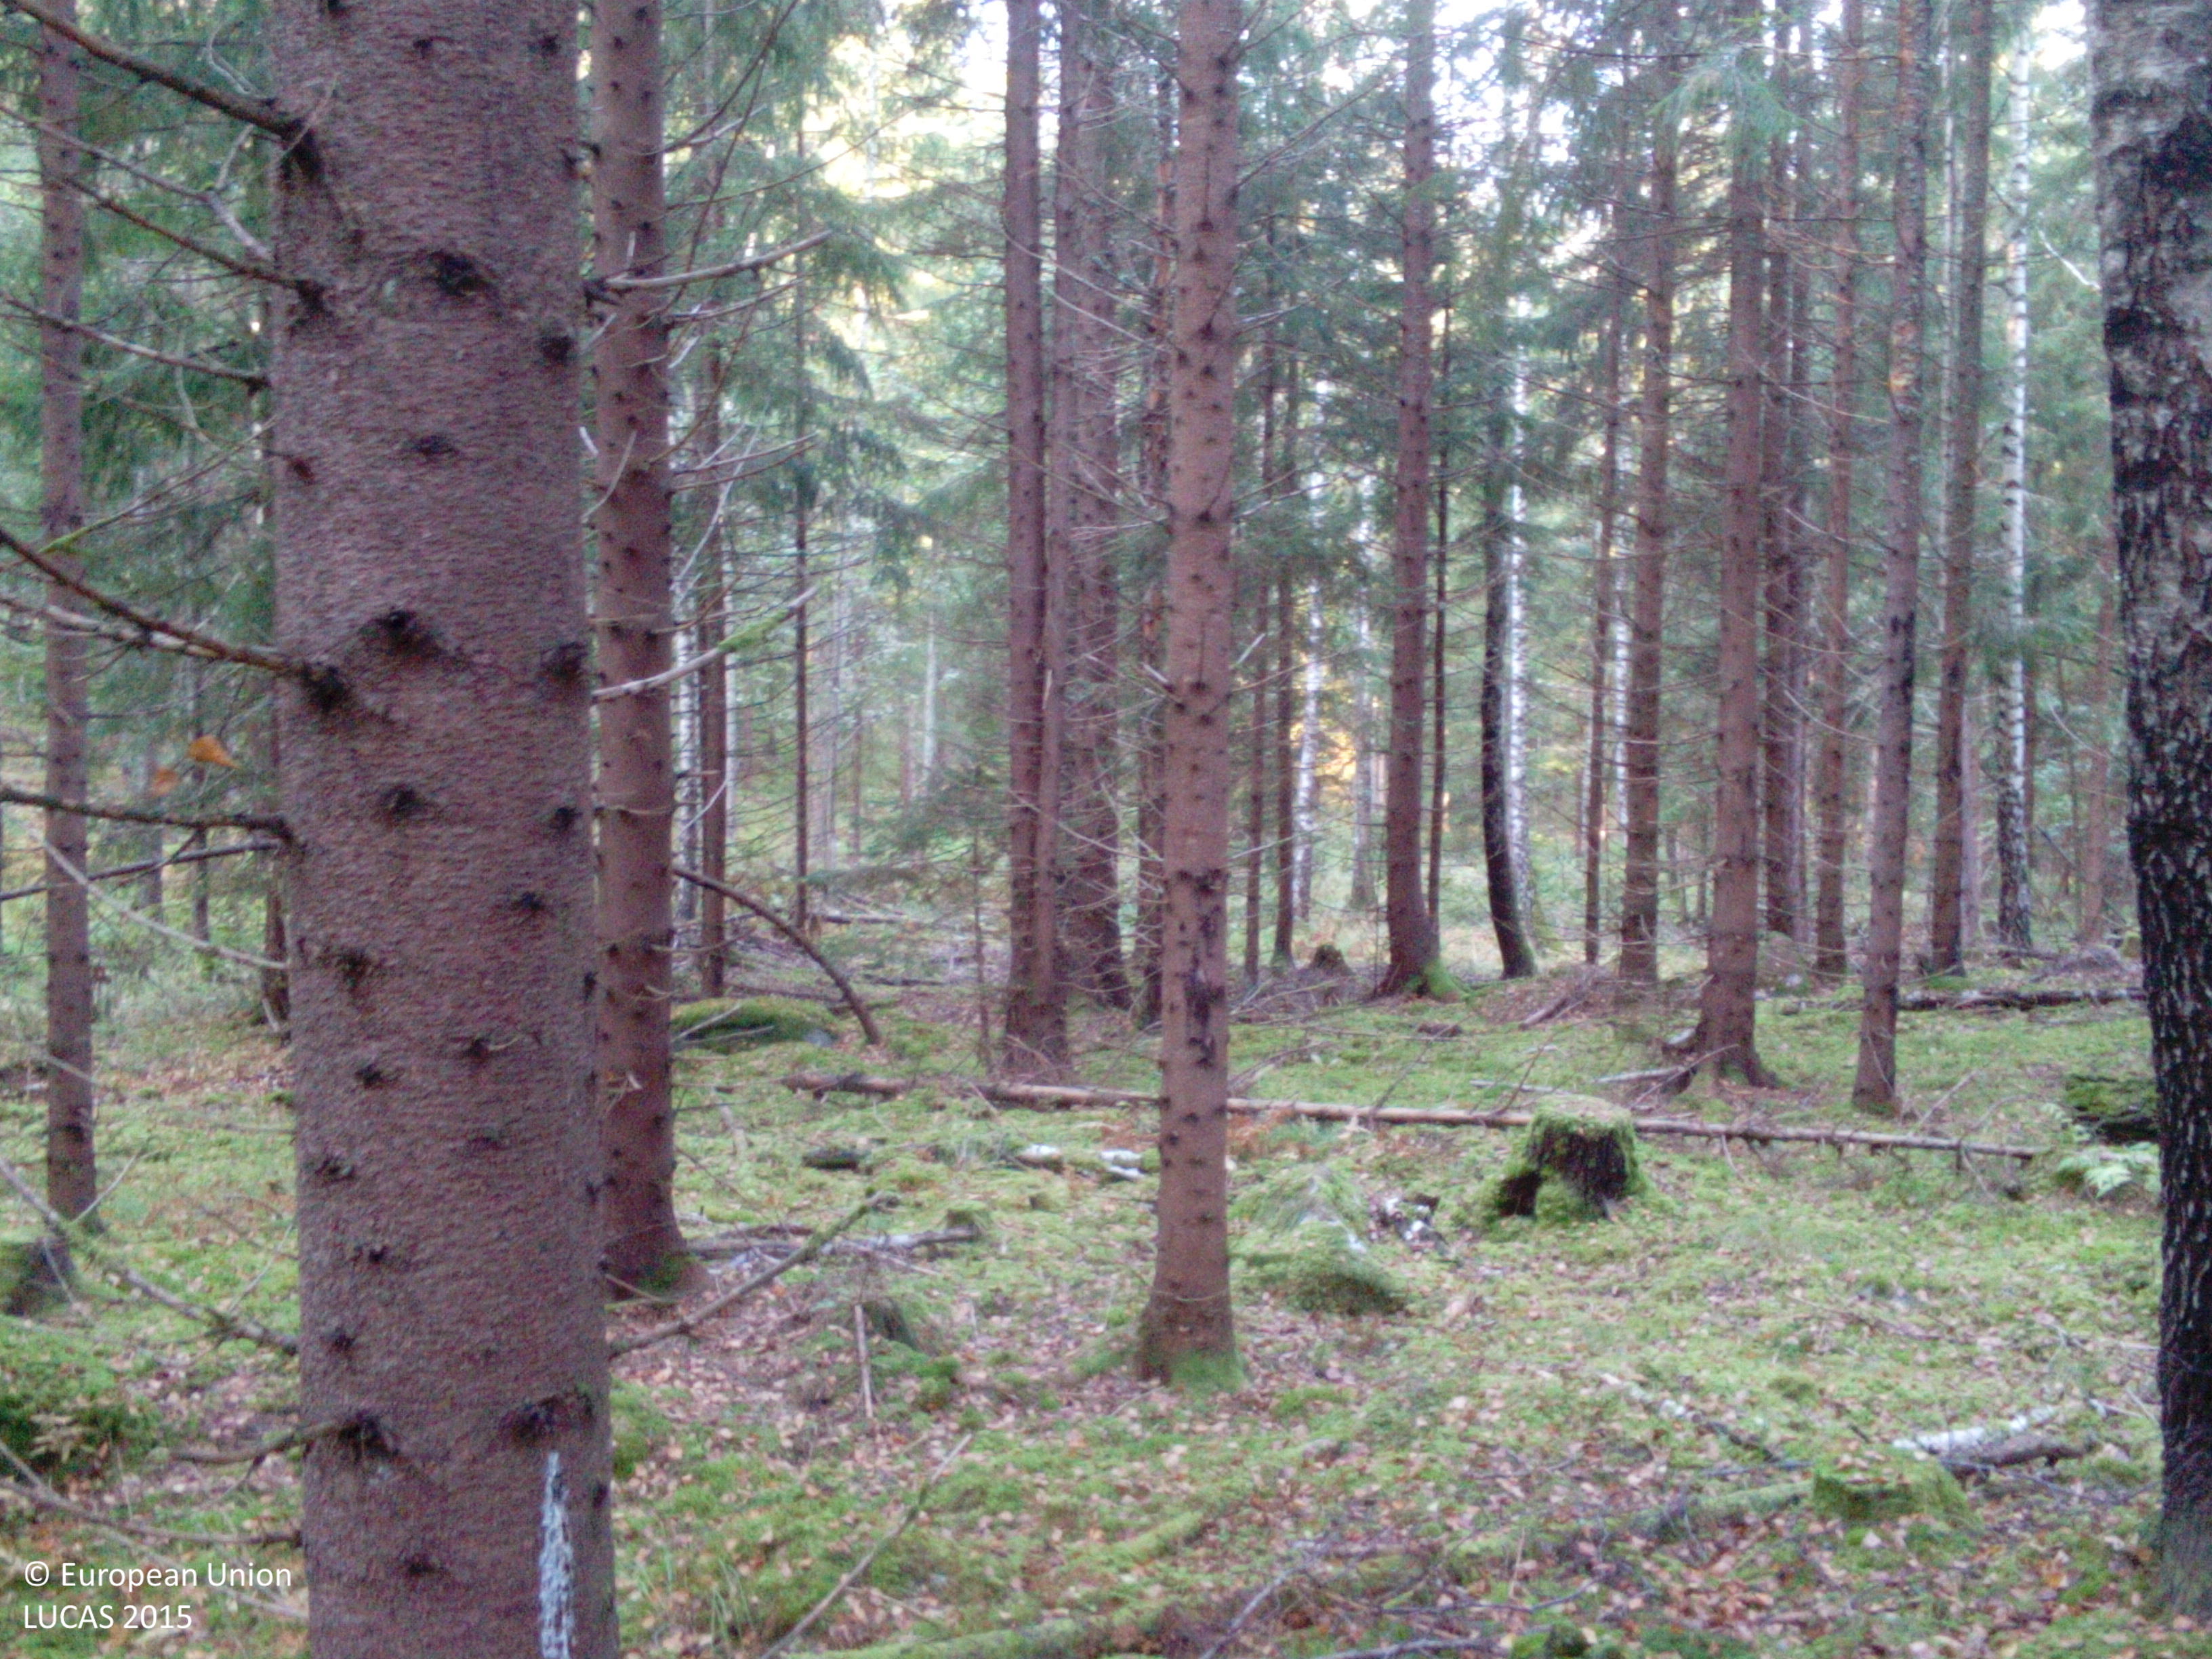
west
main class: Woodland
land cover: Spruce dominated mixed woodland
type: boreal forest
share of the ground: > 75 %
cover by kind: coniferous forest trees 65 %, broadleaved forest trees 25 %, lichens and mosses 10 %
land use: Forestry
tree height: > 5 m
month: October
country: SE
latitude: 58.8518
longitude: 16.2168
